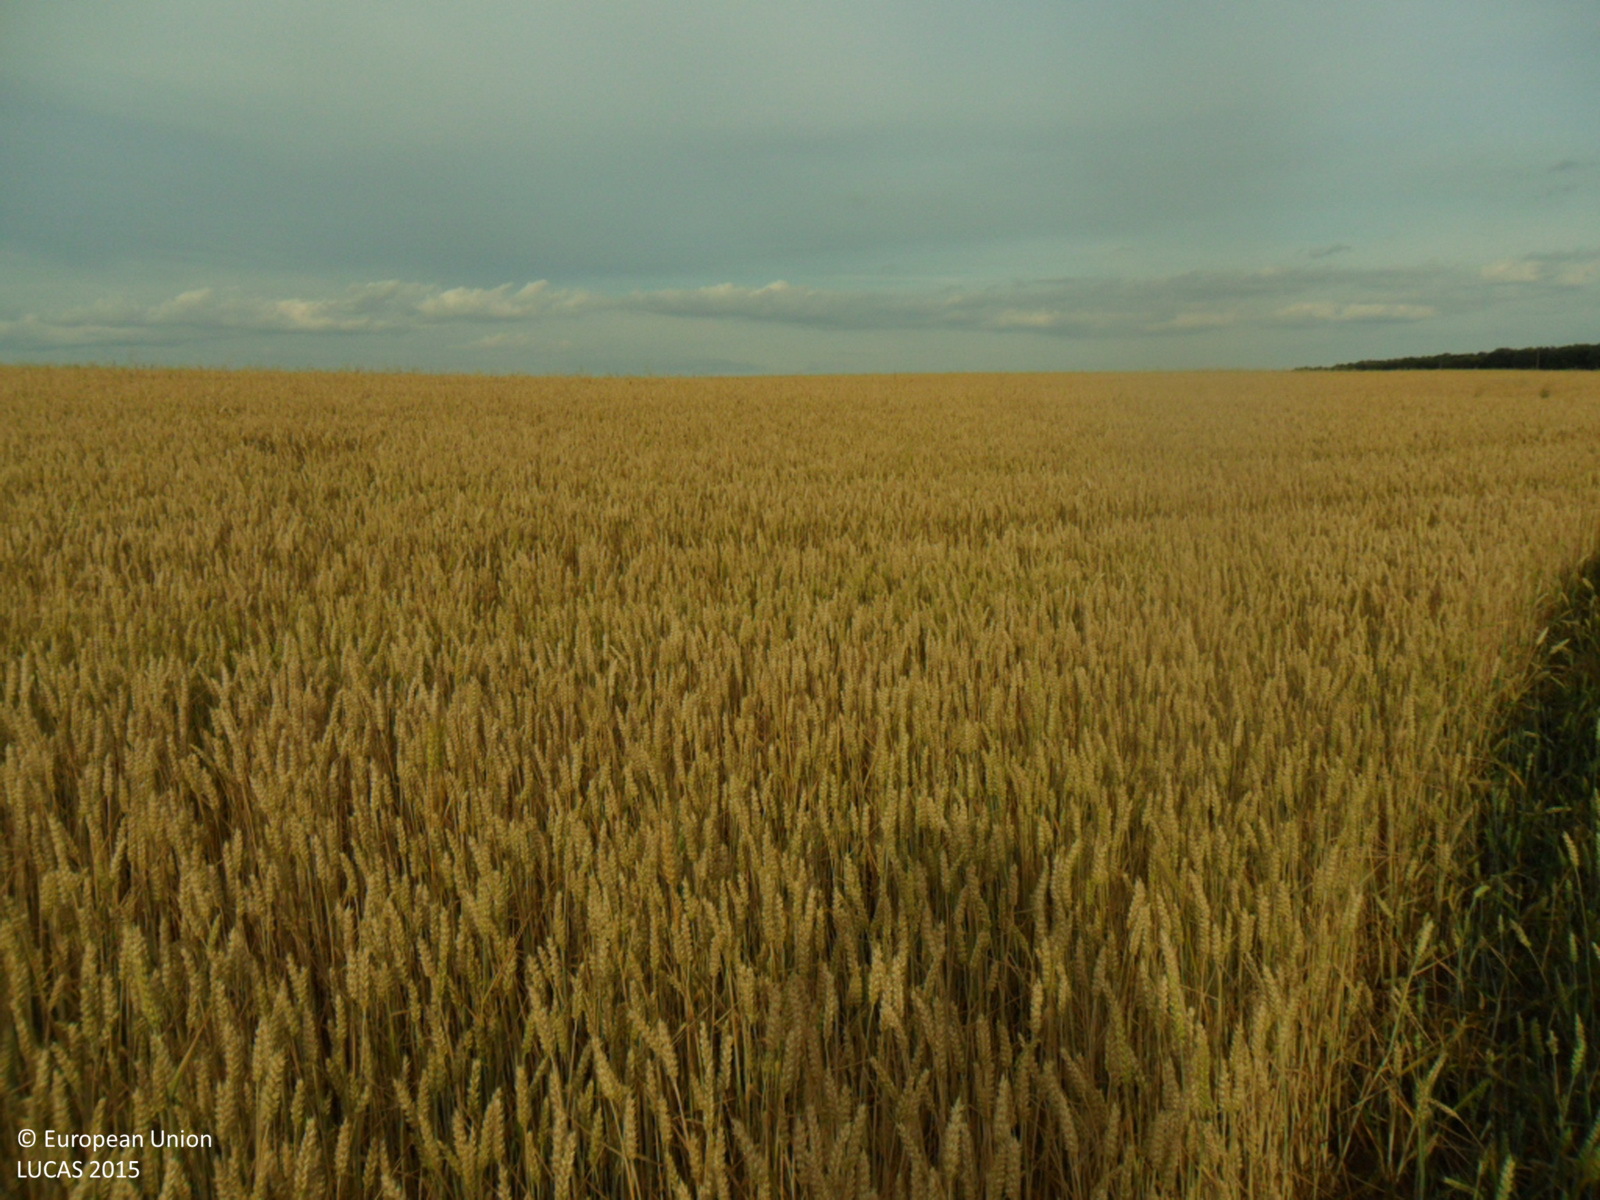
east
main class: Cropland
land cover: Common wheat
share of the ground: > 75 %
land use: Agriculture (excluding fallow land and kitchen gardens)
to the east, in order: Common wheat
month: June
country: BG
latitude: 43.5795
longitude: 26.6668
